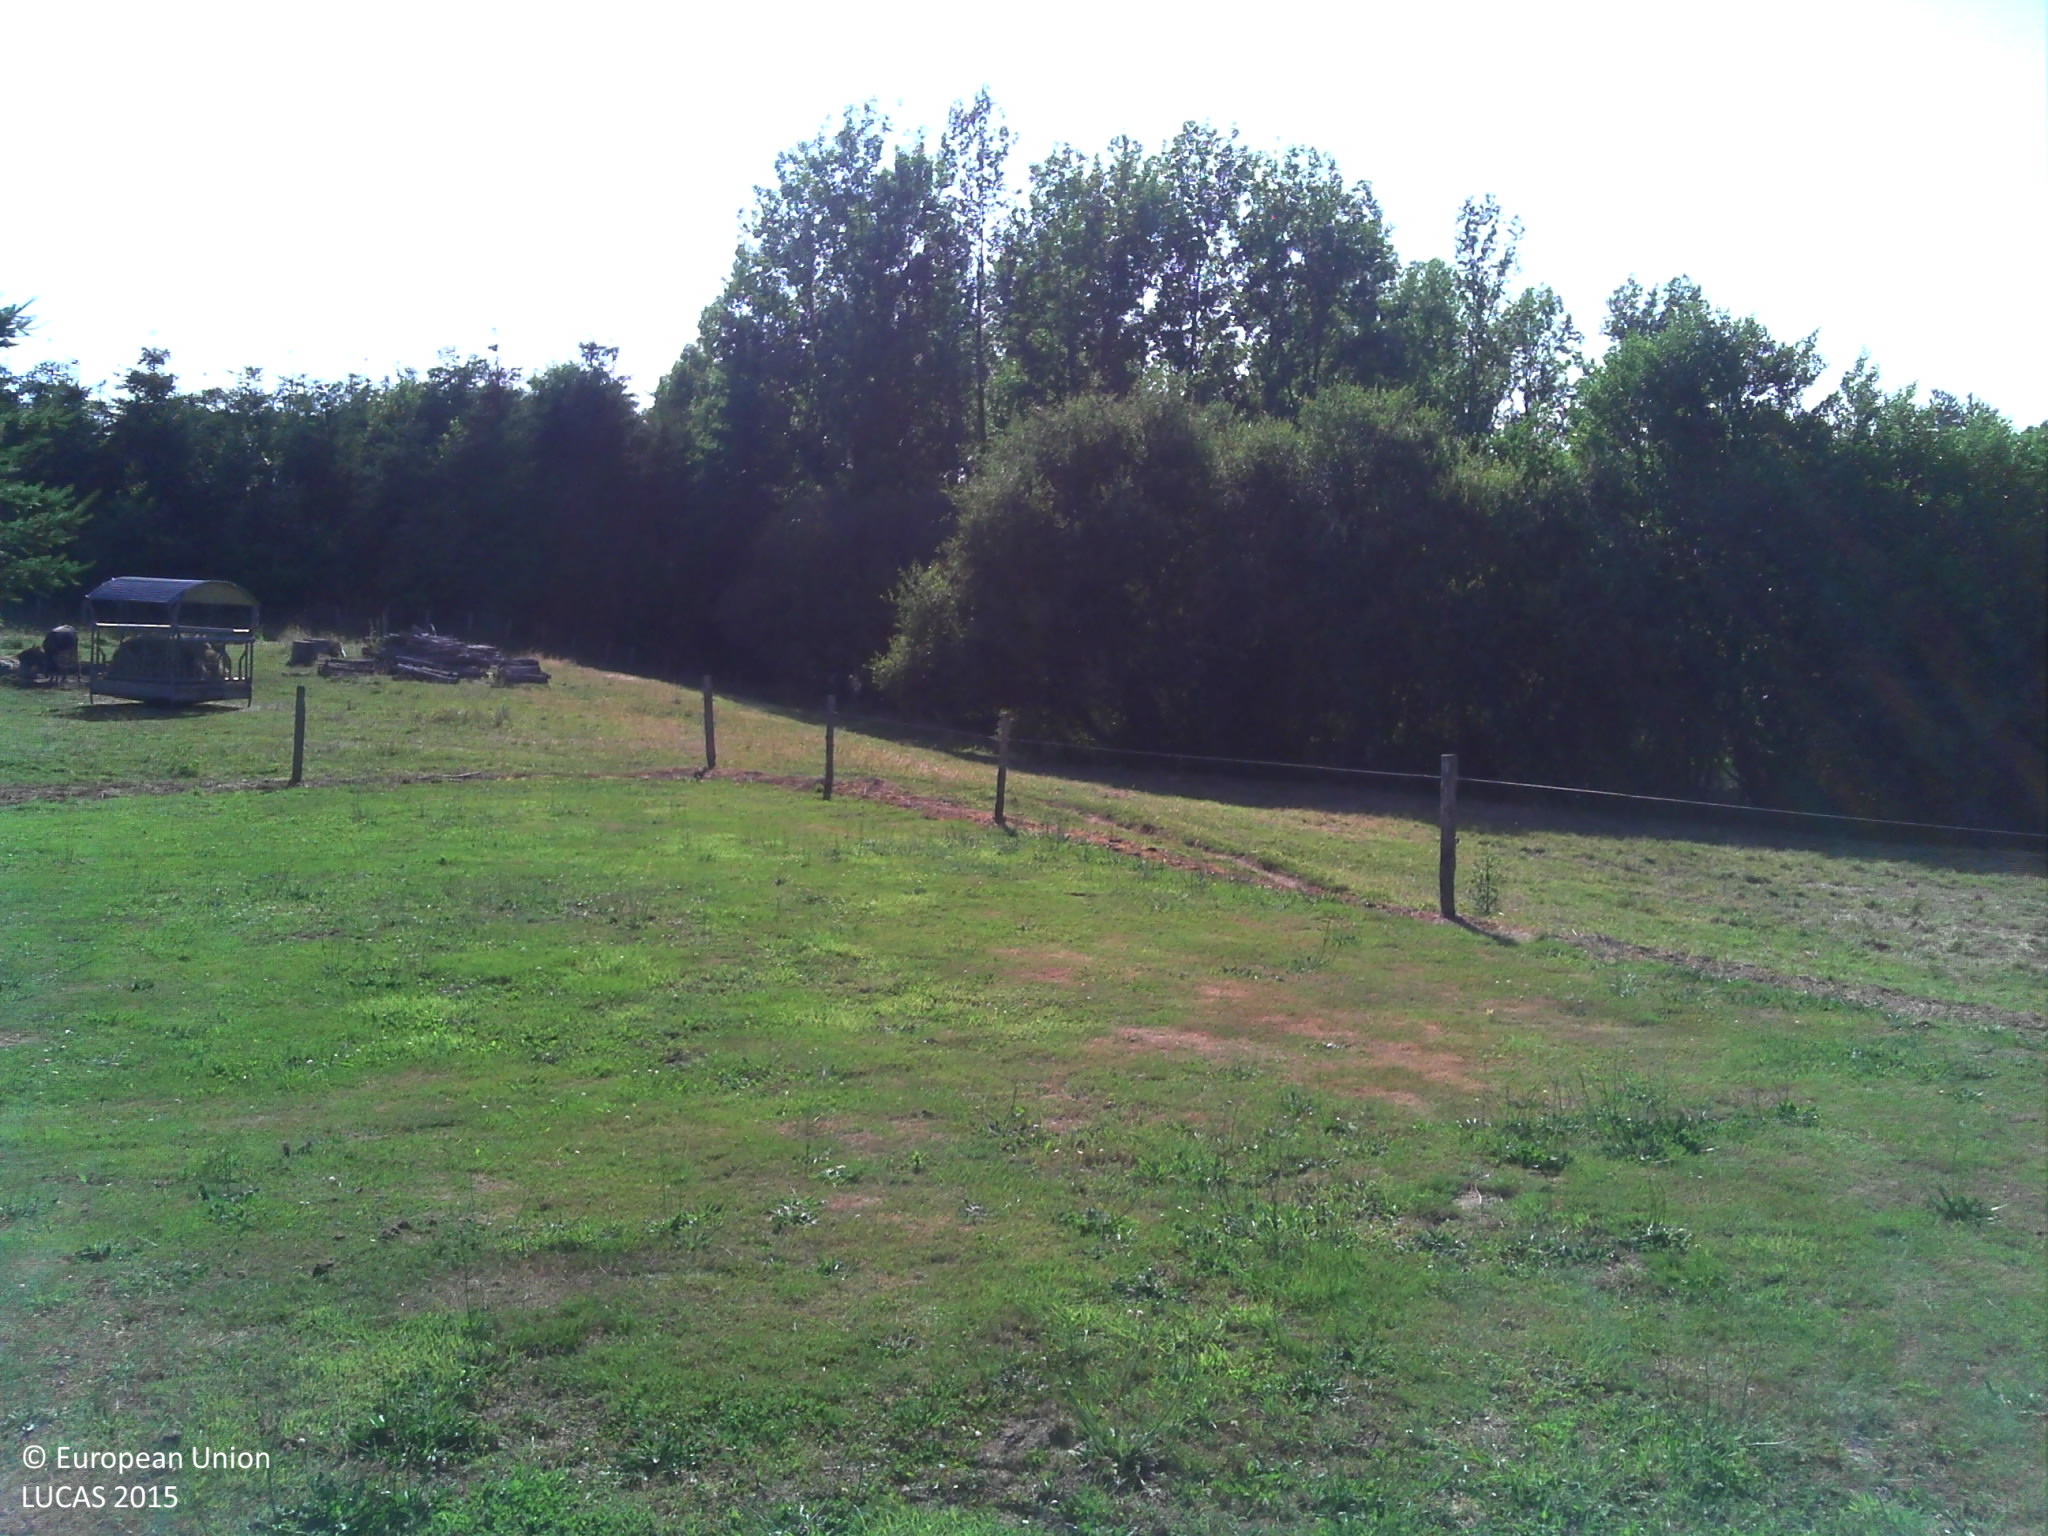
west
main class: Grassland
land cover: Grassland with sparse tree/shrub cover
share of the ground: > 75 %
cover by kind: herbaceous plants 95 %, broadleaved forest trees 5 %
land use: Residential
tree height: > 5 m
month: June
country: FR
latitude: 45.7363
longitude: 0.5922
